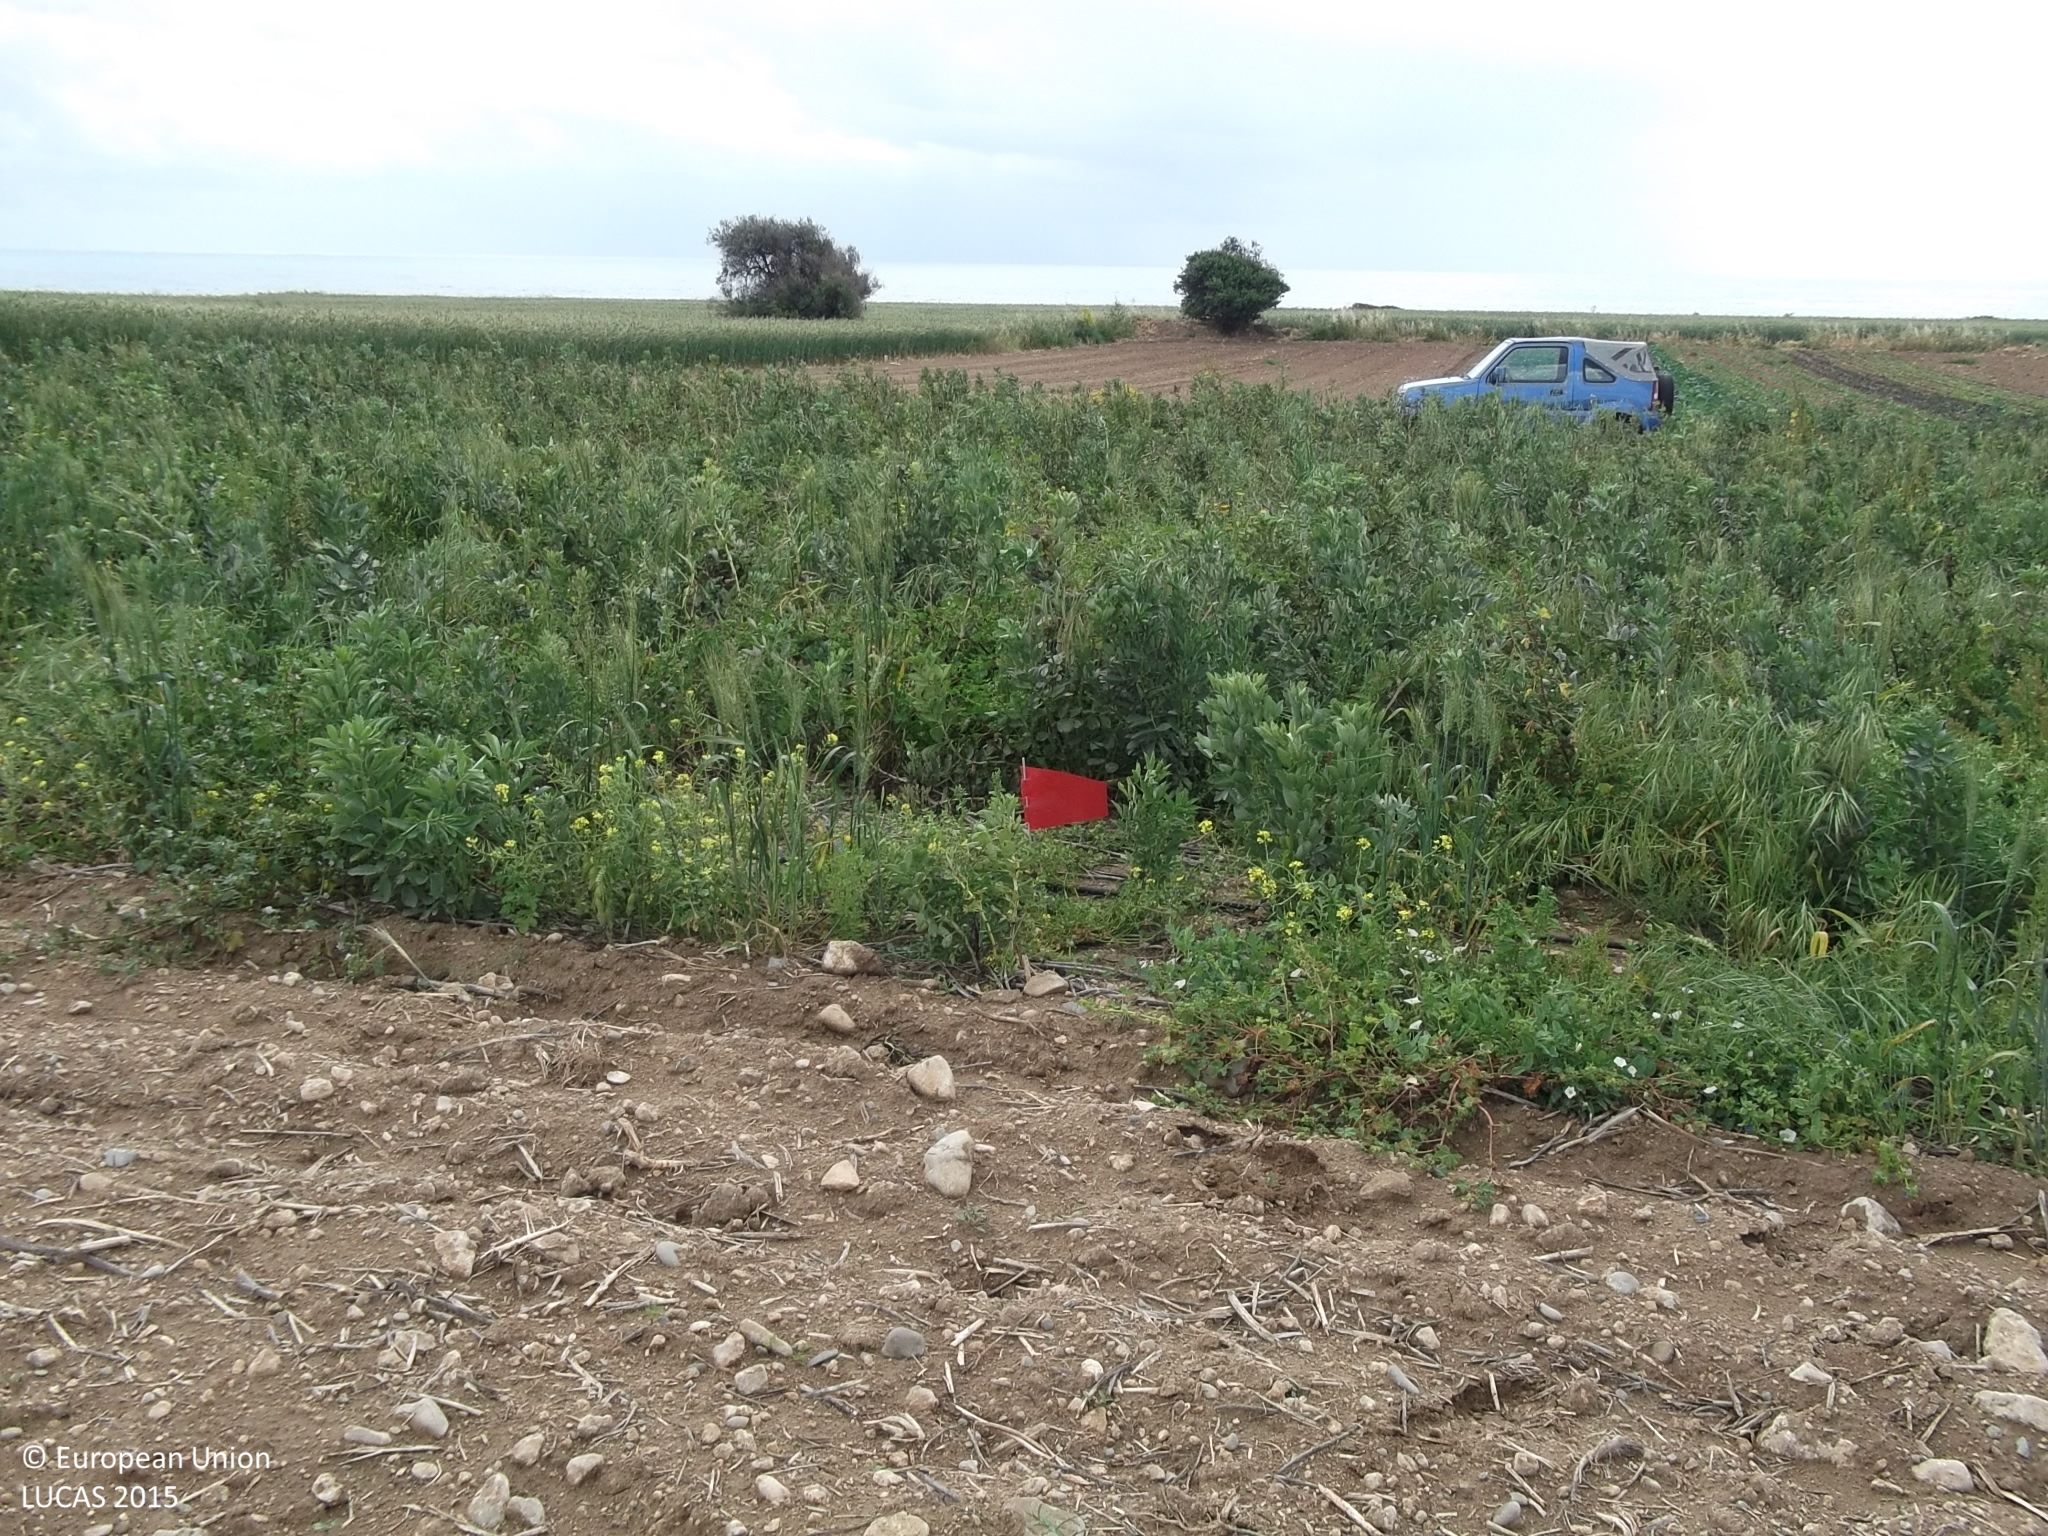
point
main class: Cropland
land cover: Dry pulses
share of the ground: > 75 %
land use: Agriculture (excluding fallow land and kitchen gardens)
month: April
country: CY
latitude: 34.7487
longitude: 33.3933
